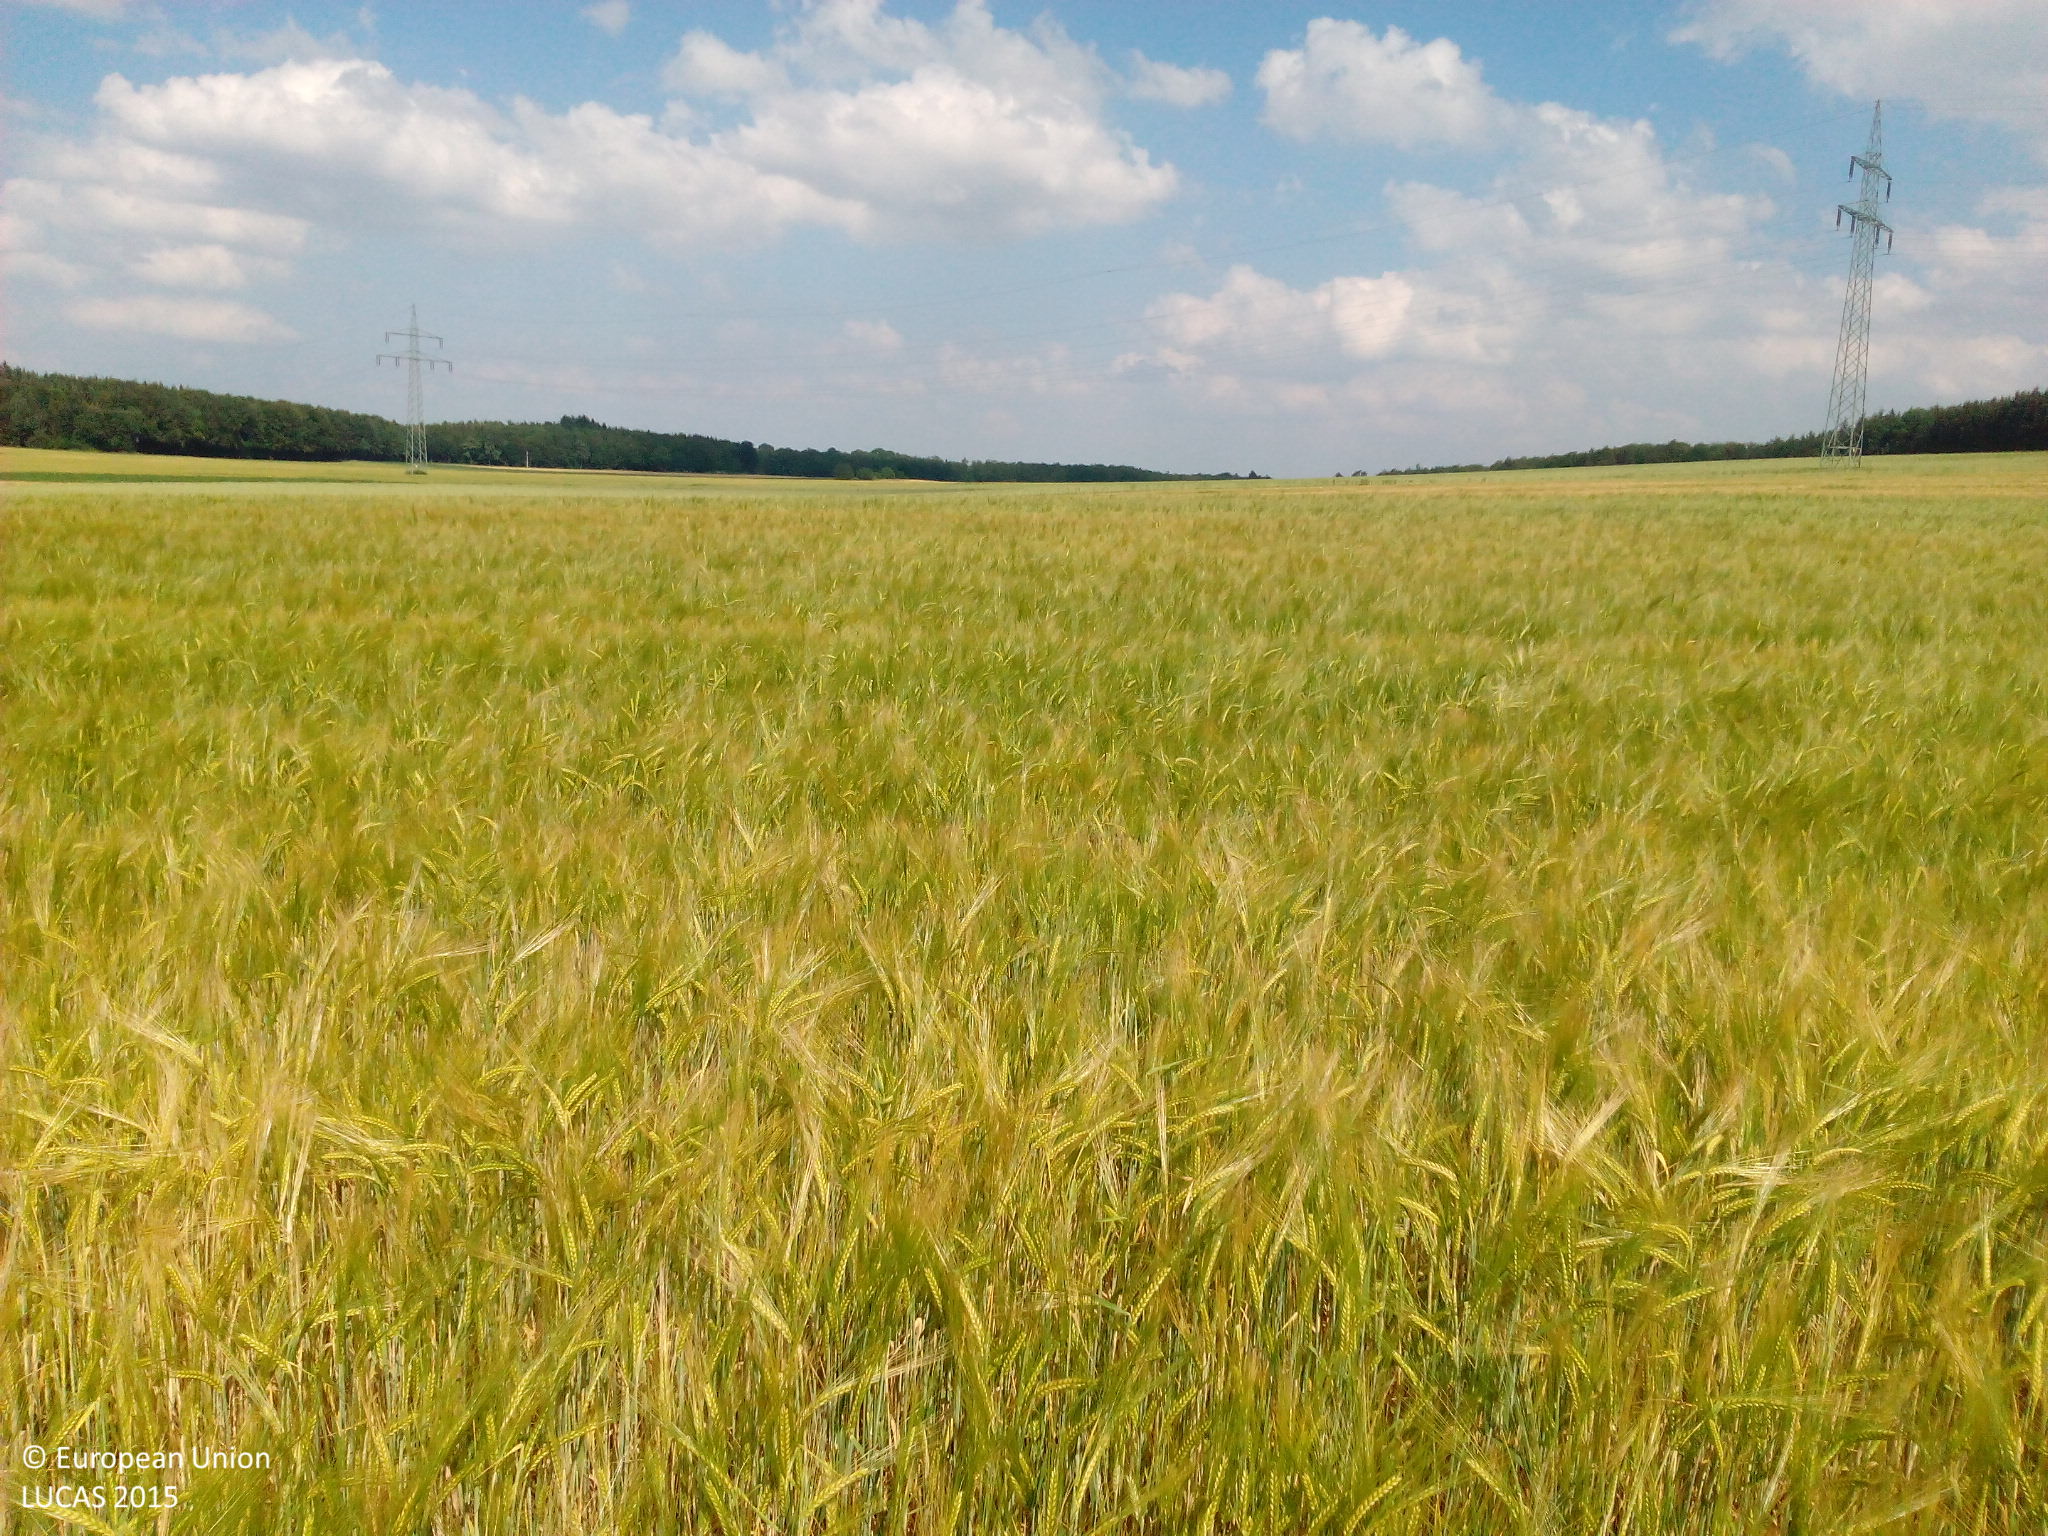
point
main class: Cropland
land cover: Barley
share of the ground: > 75 %
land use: Agriculture (excluding fallow land and kitchen gardens)
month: July
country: DE
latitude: 48.4390
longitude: 9.6893
